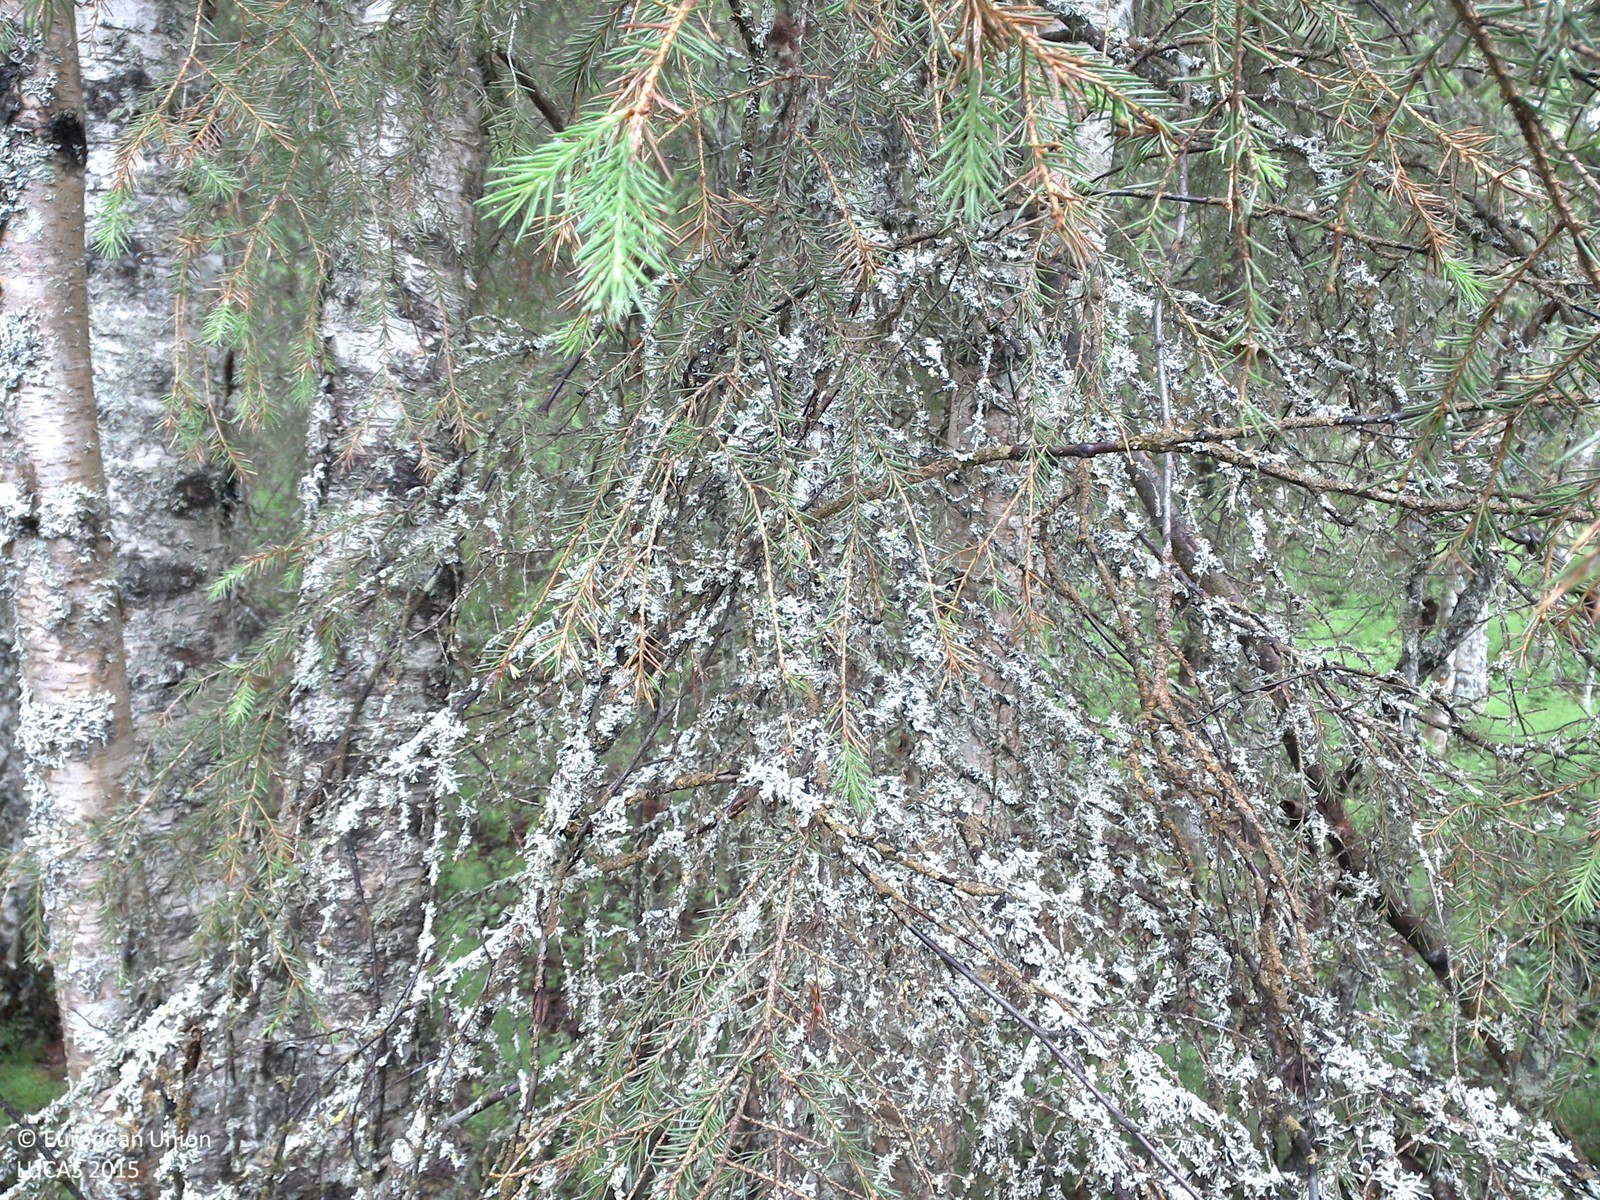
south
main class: Woodland
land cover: Spruce dominated mixed woodland
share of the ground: 50 - 75 %
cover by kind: coniferous forest trees 30 %, herbaceous plants 30 %, broadleaved forest trees 25 %, shrubs 10 %, unconsolidated bare surface 5 %
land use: Forestry
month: July
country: SE
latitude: 66.5689
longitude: 23.3906
